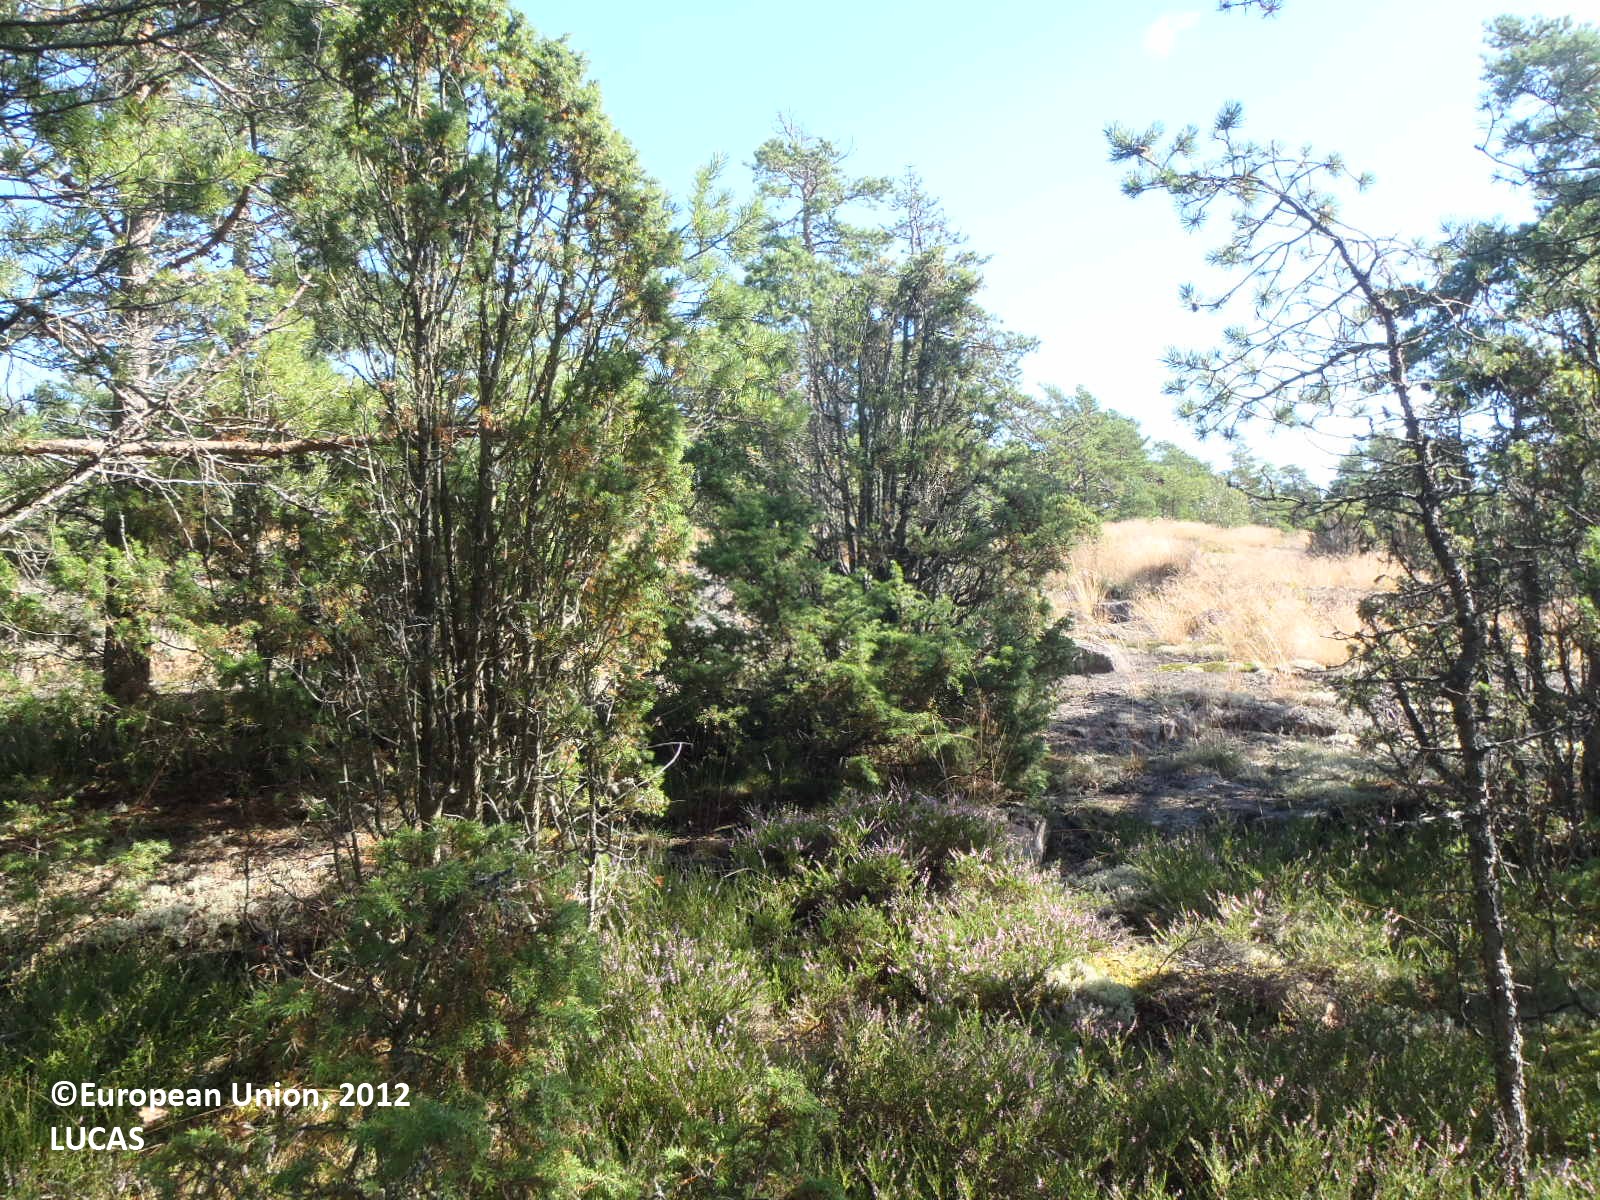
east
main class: Woodland
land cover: Pine dominated coniferous woodland
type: hemiboreal forest and nemoral coniferous forest and mixed broadleaved-coniferous forest
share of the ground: > 75 %
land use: Forestry
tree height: > 5 m
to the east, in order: Pine dominated coniferous woodland; Lichens and moss; Single bushes/trees; Lichens and moss; Pine dominated coniferous woodland
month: August
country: FI
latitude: 60.1741
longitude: 19.9382
